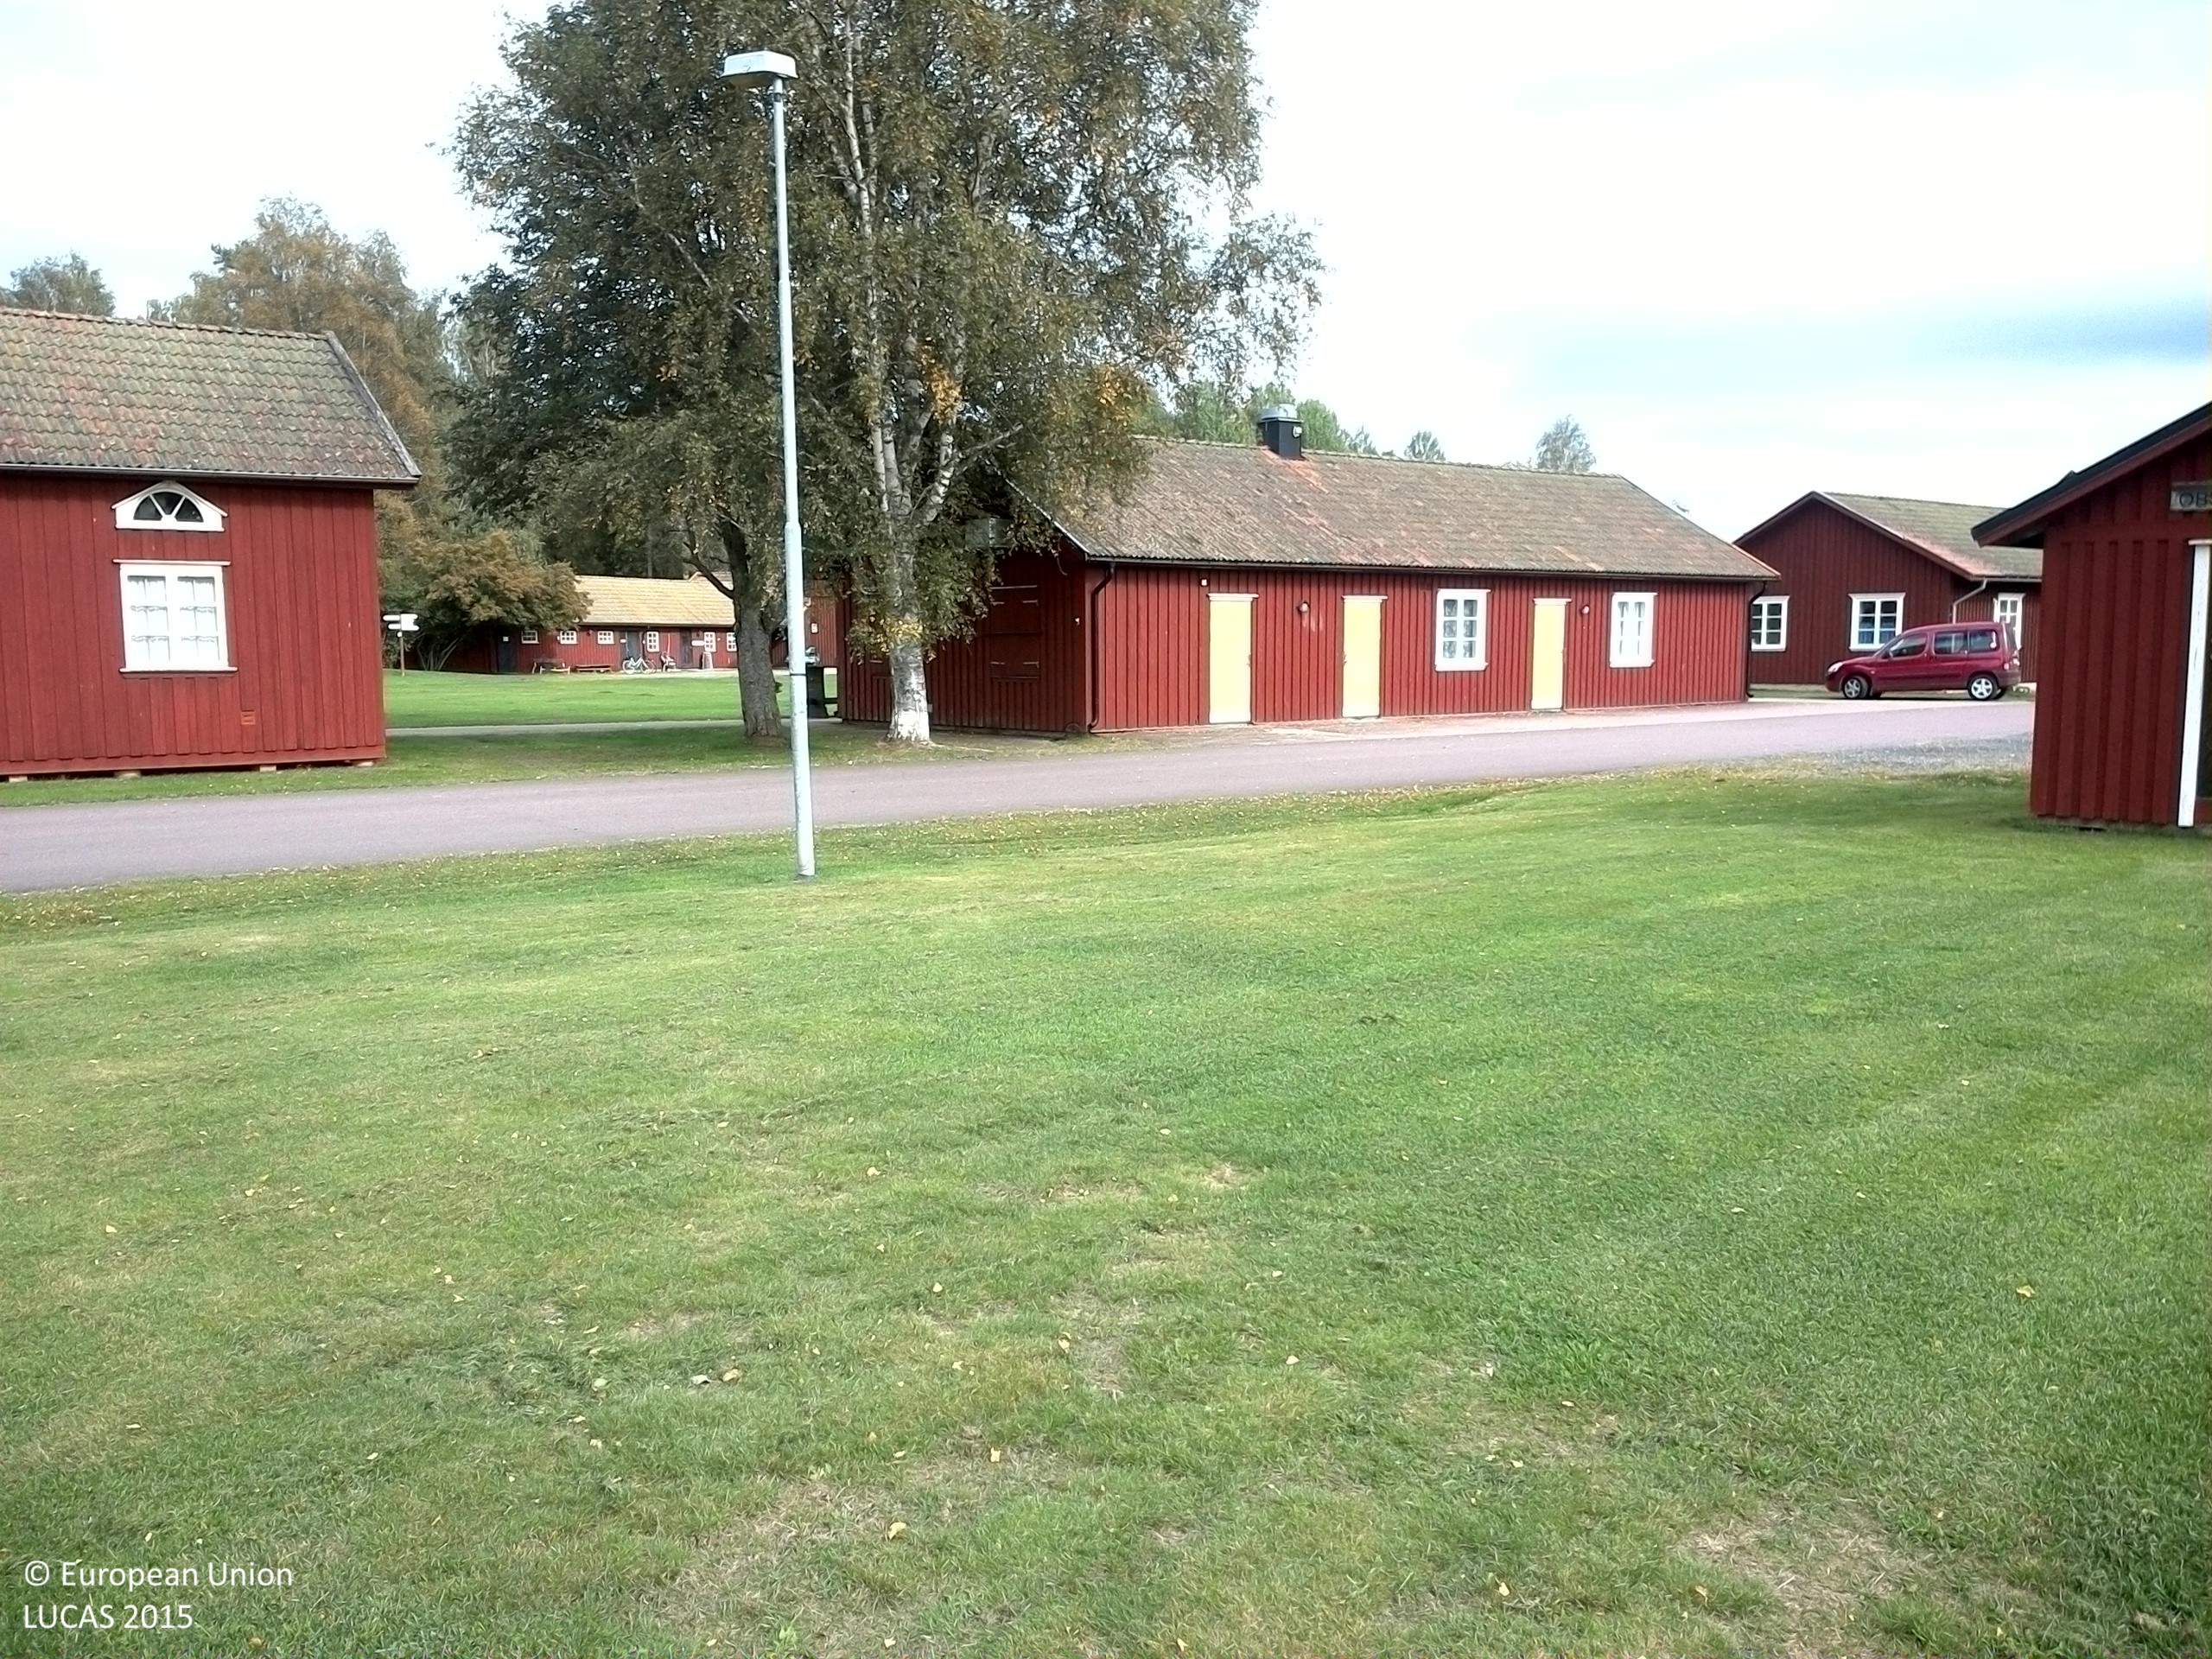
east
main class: Grassland
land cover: Grassland without tree/shrub cover
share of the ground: > 75 %
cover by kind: herbaceous plants 95 %, consolidated bare surface 5 %
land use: Amenities, museums, leisure
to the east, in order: Grassland without tree/shrub cover; Artificial constructions in urban areas; Broadleaved woodland; Rivers and streams; Broadleaved woodland
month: September
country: SE
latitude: 59.7778
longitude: 13.4645
